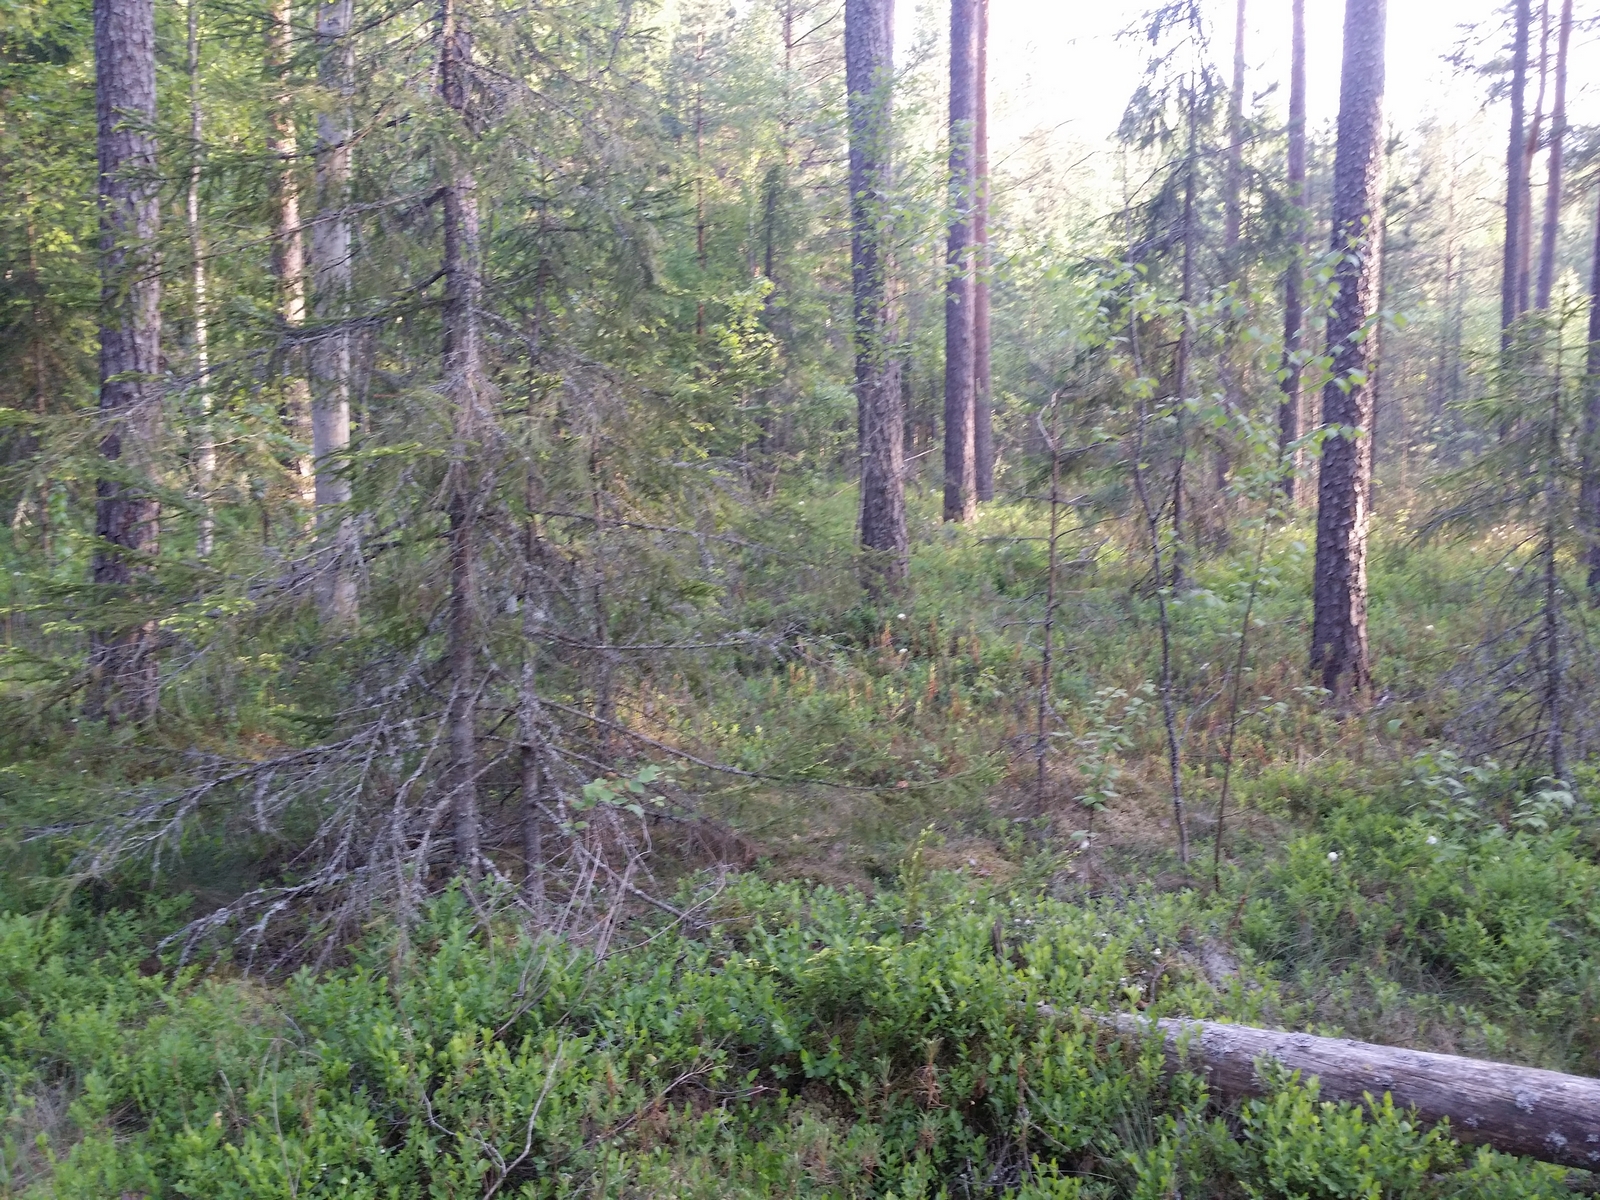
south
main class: Woodland
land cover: Other coniferous woodland
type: hemiboreal forest and nemoral coniferous forest and mixed broadleaved-coniferous forest
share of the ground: > 75 %
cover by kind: coniferous forest trees 80 %, lichens and mosses 20 %
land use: Forestry
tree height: > 5 m
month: June
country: LV
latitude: 57.2787
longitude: 26.5156
